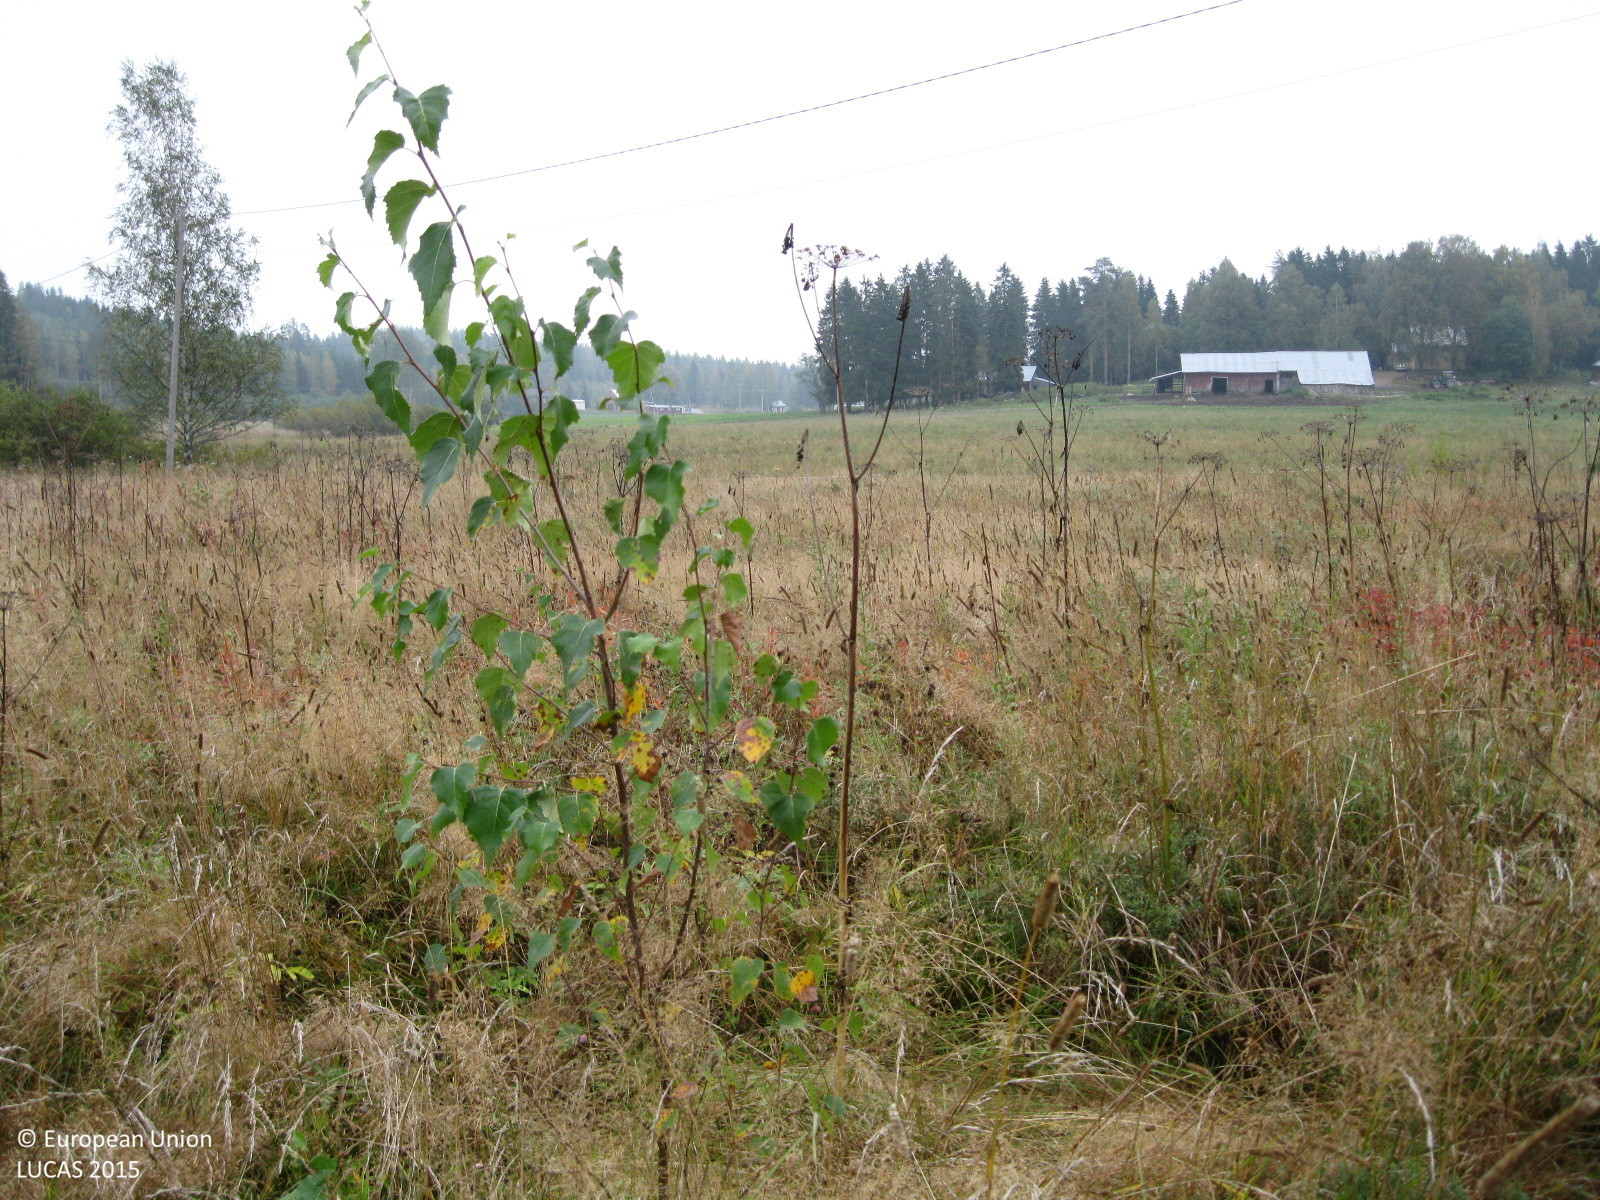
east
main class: Grassland
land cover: Spontaneously vegetated surfaces
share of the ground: > 75 %
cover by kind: herbaceous plants 100 %
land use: Fallow land
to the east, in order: Spontaneously vegetated surfaces; Electric lines; Spontaneously vegetated surfaces; Ditches and canals; Grass margins; Fences; Grassland without tree/shrub cover; Fences; Electric lines; Grass margins; Fences; Temporary grasslands
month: September
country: FI
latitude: 60.8712
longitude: 24.9006
